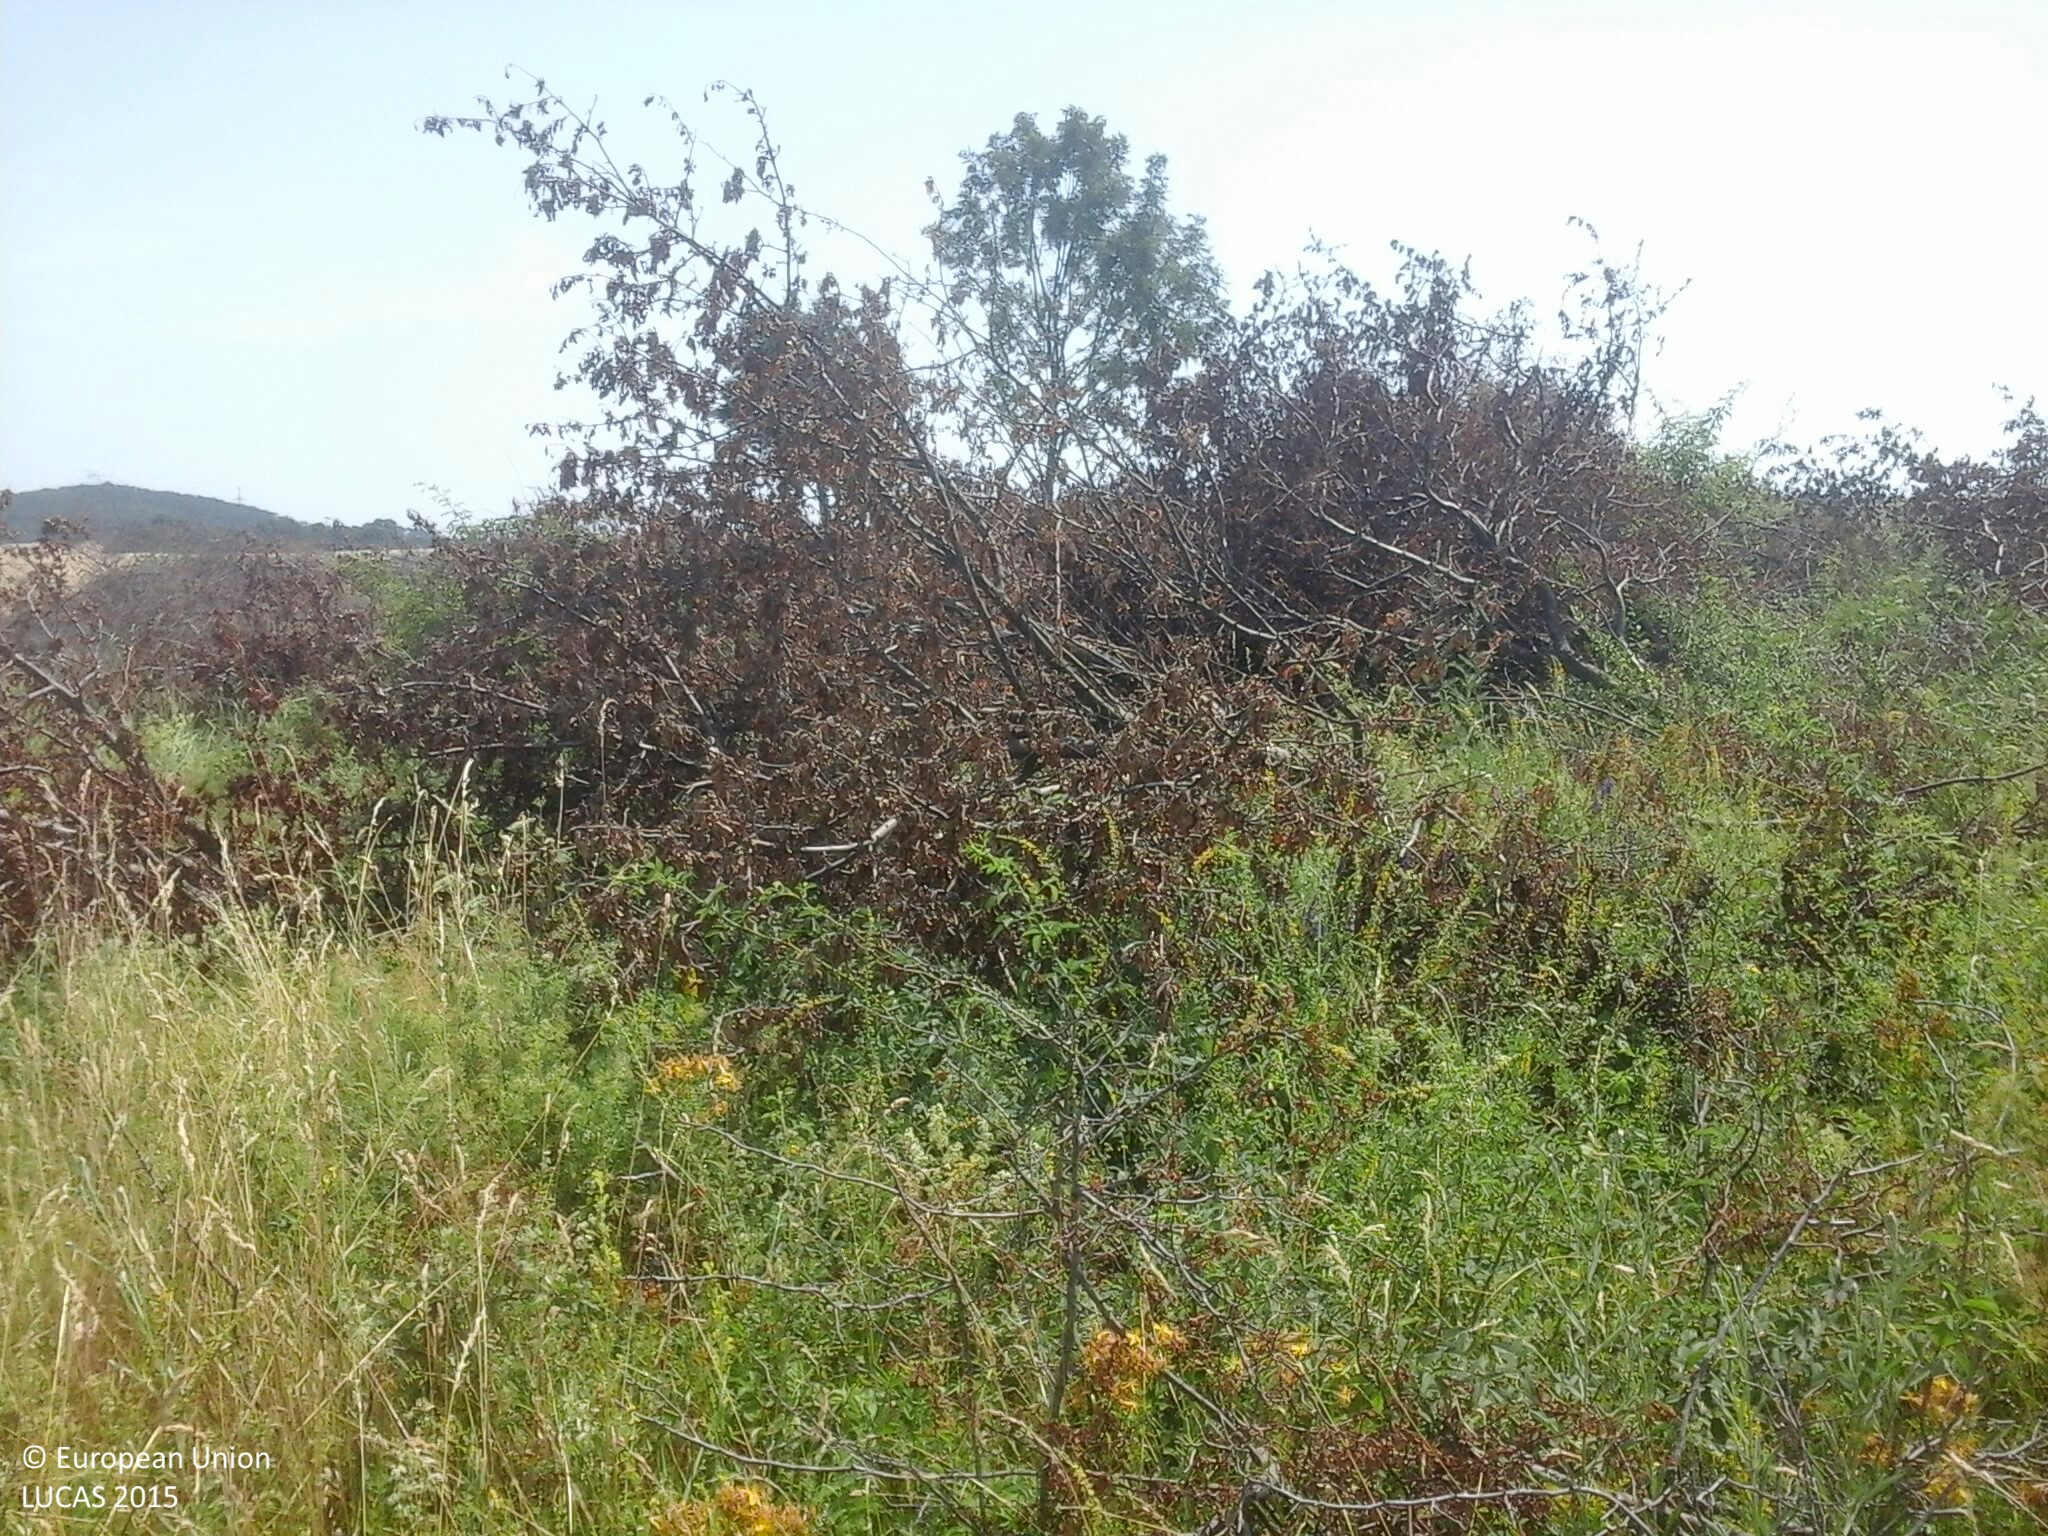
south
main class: Grassland
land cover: Grassland with sparse tree/shrub cover
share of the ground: > 75 %
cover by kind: herbaceous plants 90 %, broadleaved forest trees 5 %, shrubs 5 %
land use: Agriculture (excluding fallow land and kitchen gardens)
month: July
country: HU
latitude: 47.0062
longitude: 17.8076
